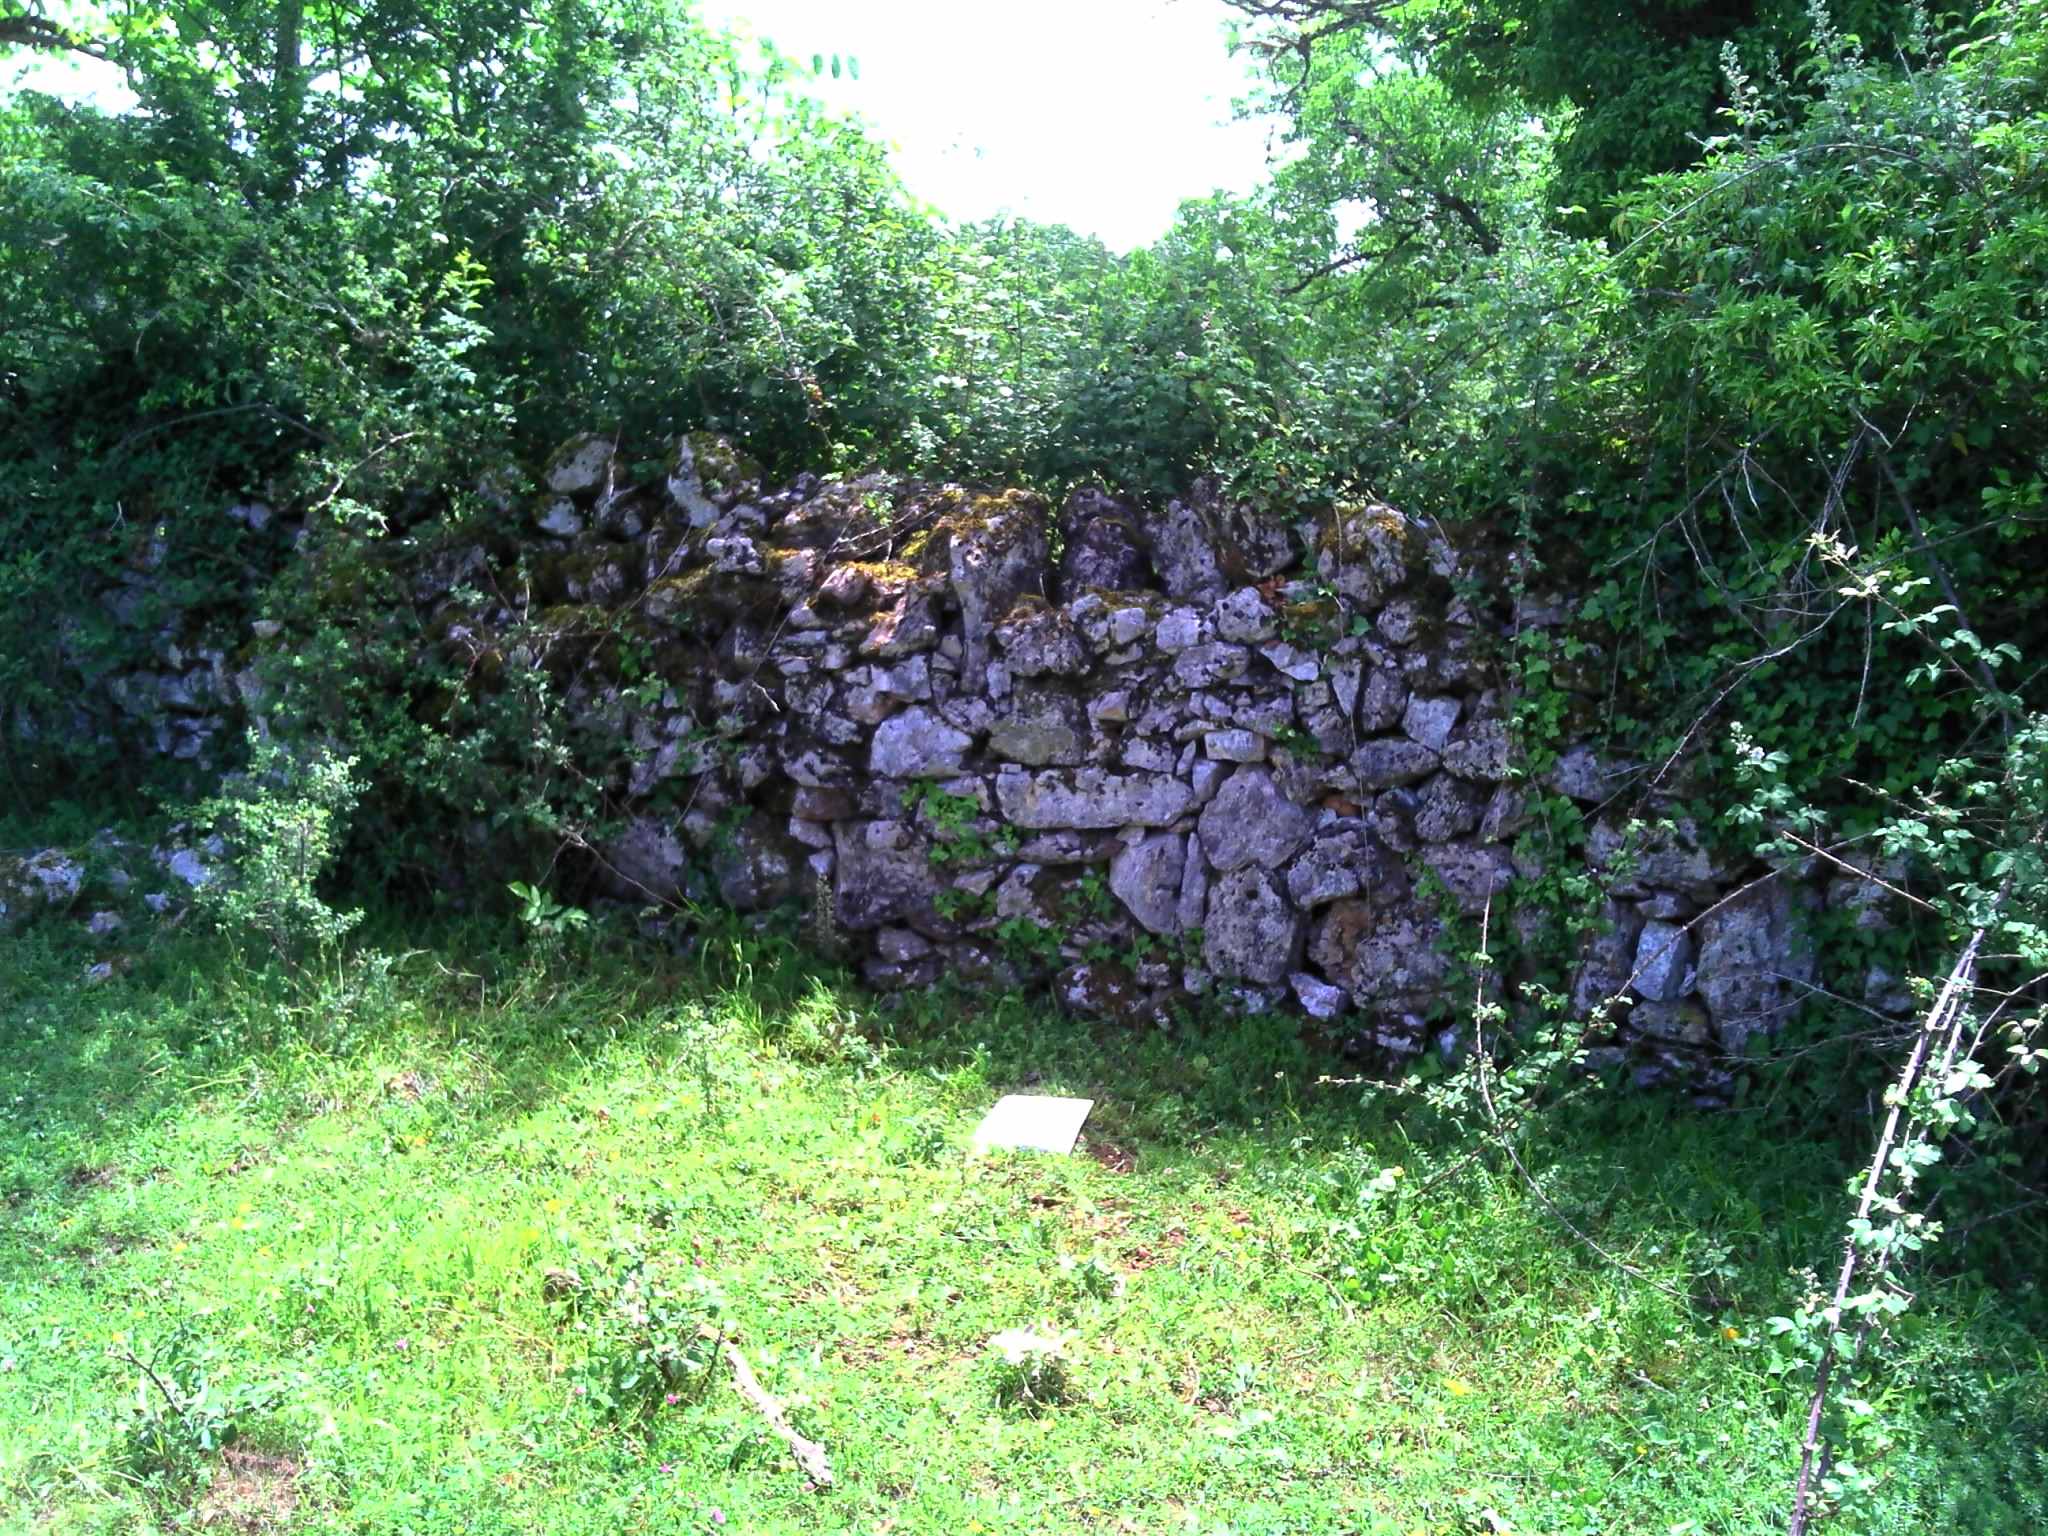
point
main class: Grassland
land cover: Grassland without tree/shrub cover
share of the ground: > 75 %
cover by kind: herbaceous plants 100 %
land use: Agriculture (excluding fallow land and kitchen gardens)
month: June
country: FR
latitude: 44.8917
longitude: 1.7547
